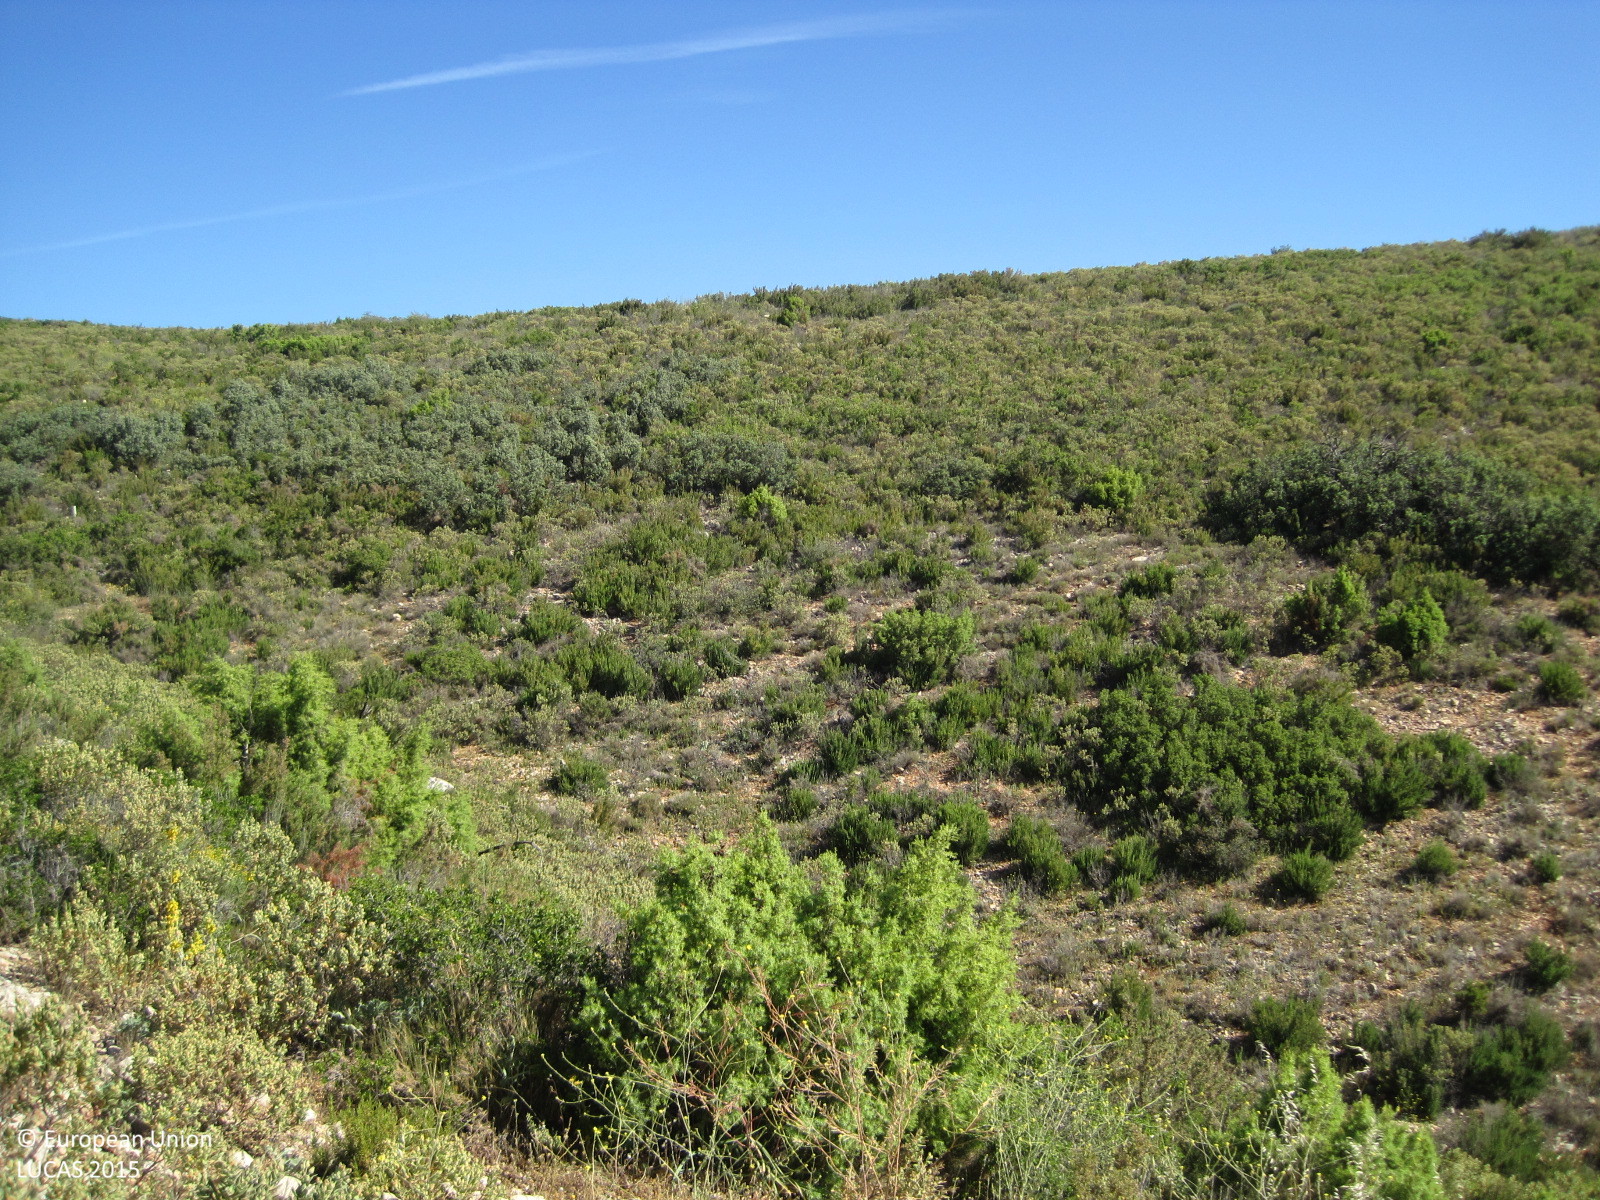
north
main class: Woodland
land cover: Broadleaved woodland
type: acidophilous oak and oak-birch forest
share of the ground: 10 - 25 %
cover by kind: shrubs 80 %, broadleaved forest trees 10 %, herbaceous plants 5 %, consolidated bare surface 5 %
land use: Semi-natural and natural areas not in use
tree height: < 5 m
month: May
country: ES
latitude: 39.4663
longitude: -0.8208
